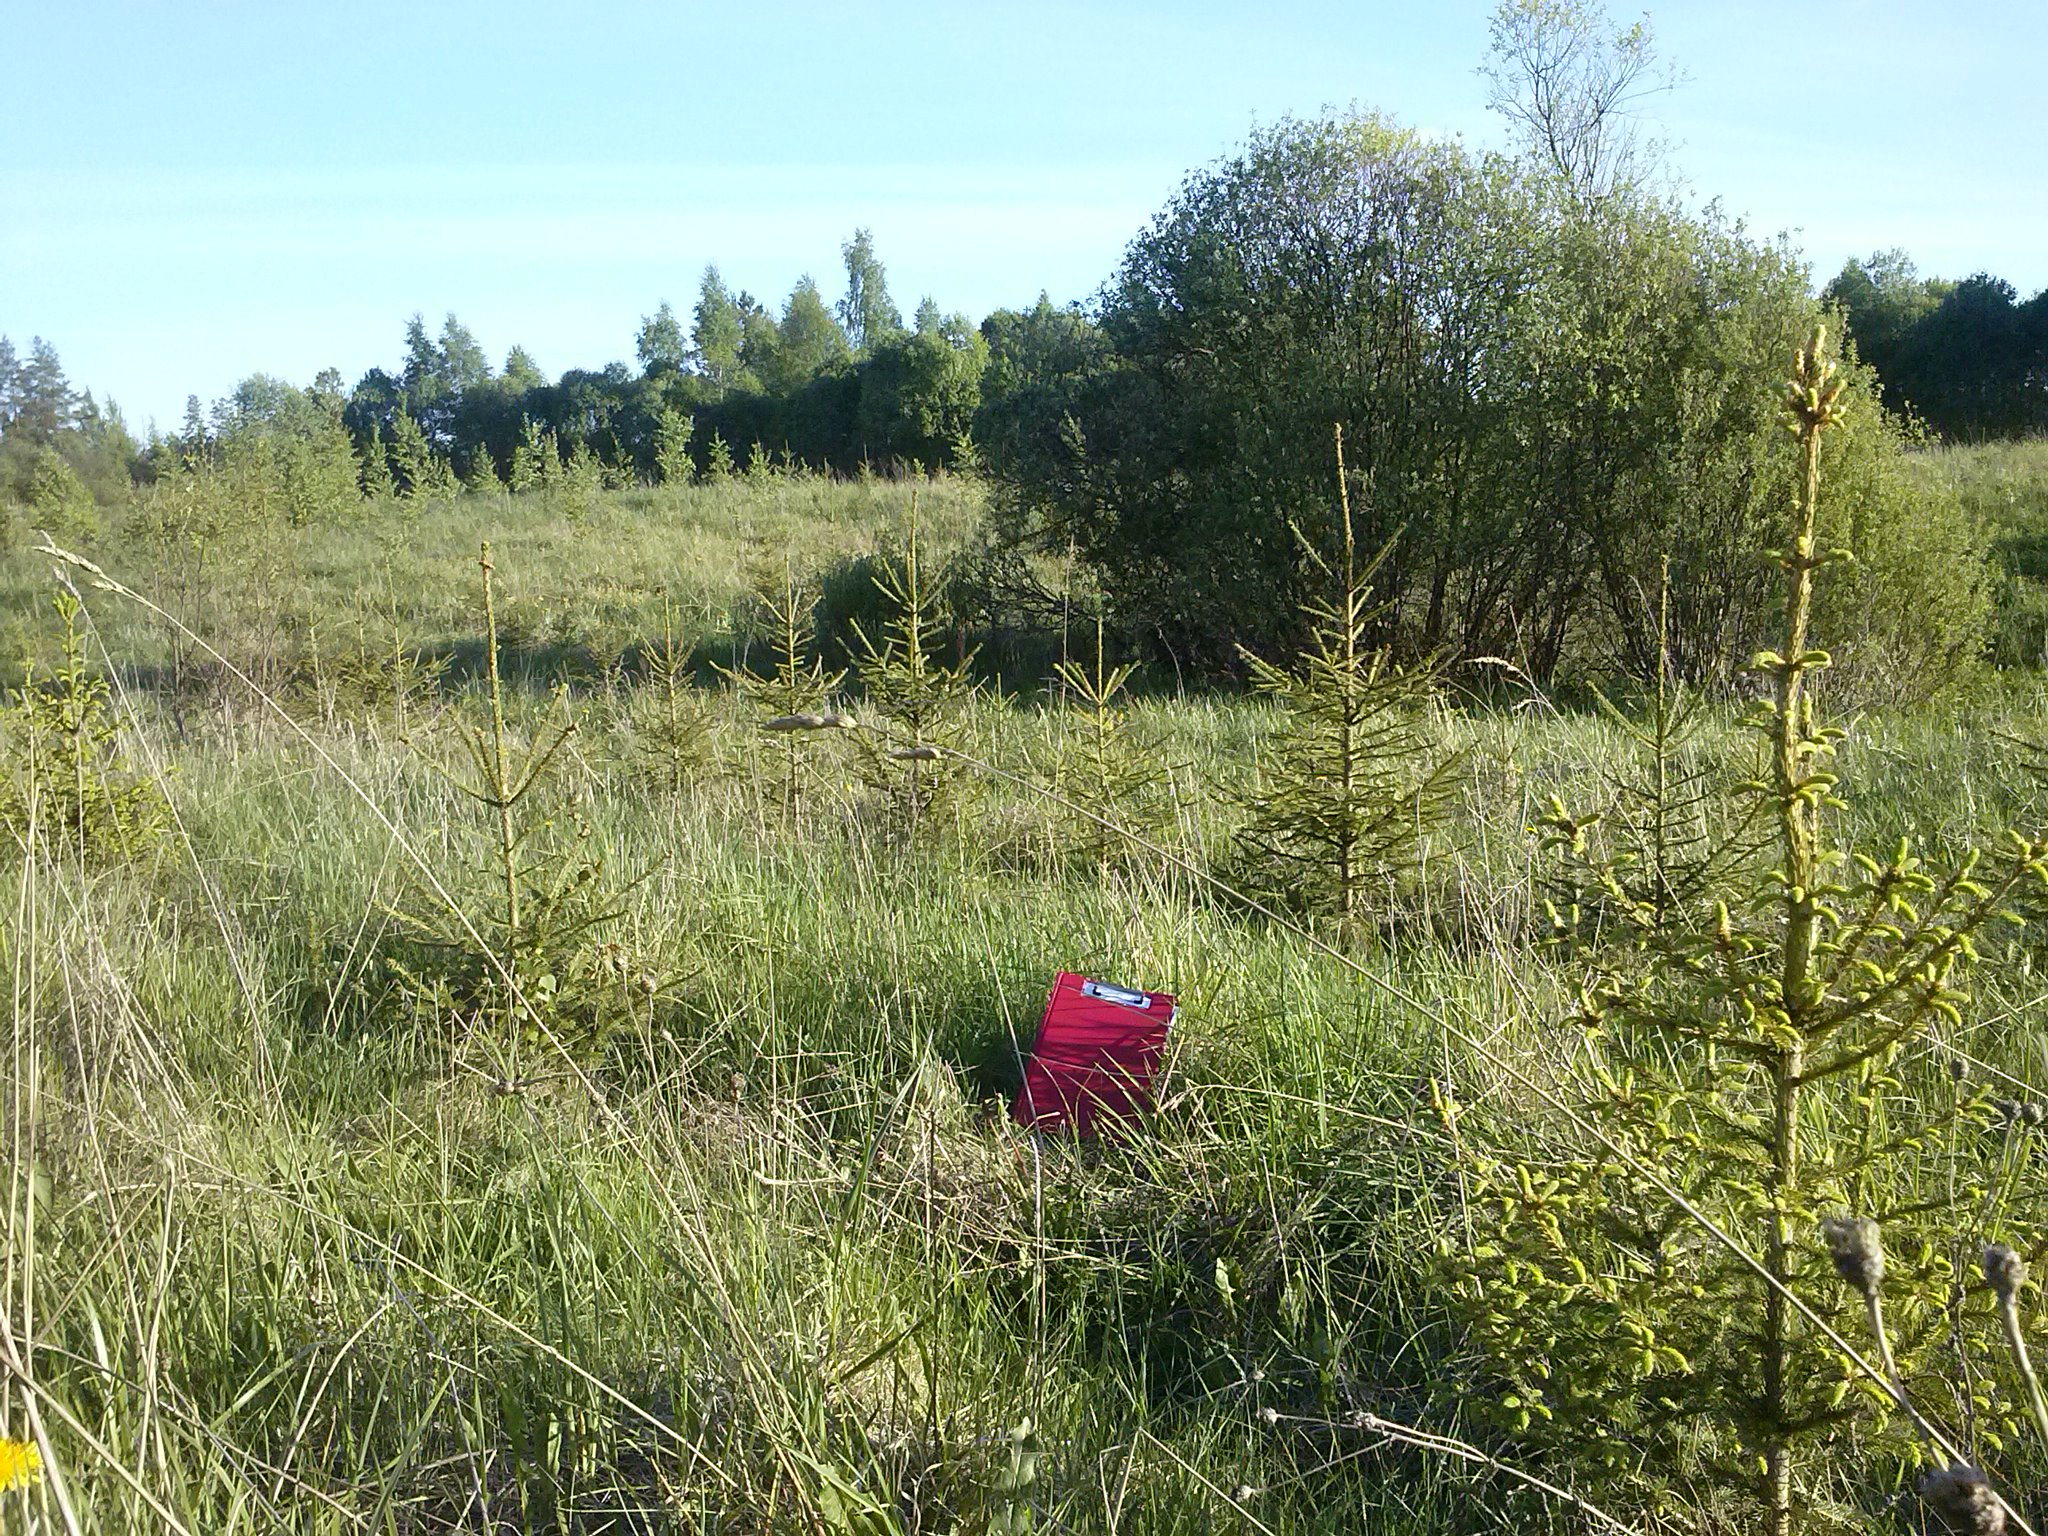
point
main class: Grassland
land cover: Grassland with sparse tree/shrub cover
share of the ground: > 75 %
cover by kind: herbaceous plants 90 %, coniferous forest trees 5 %, shrubs 5 %
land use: Forestry
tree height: < 5 m
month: May
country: LV
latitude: 56.1920
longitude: 27.8714
